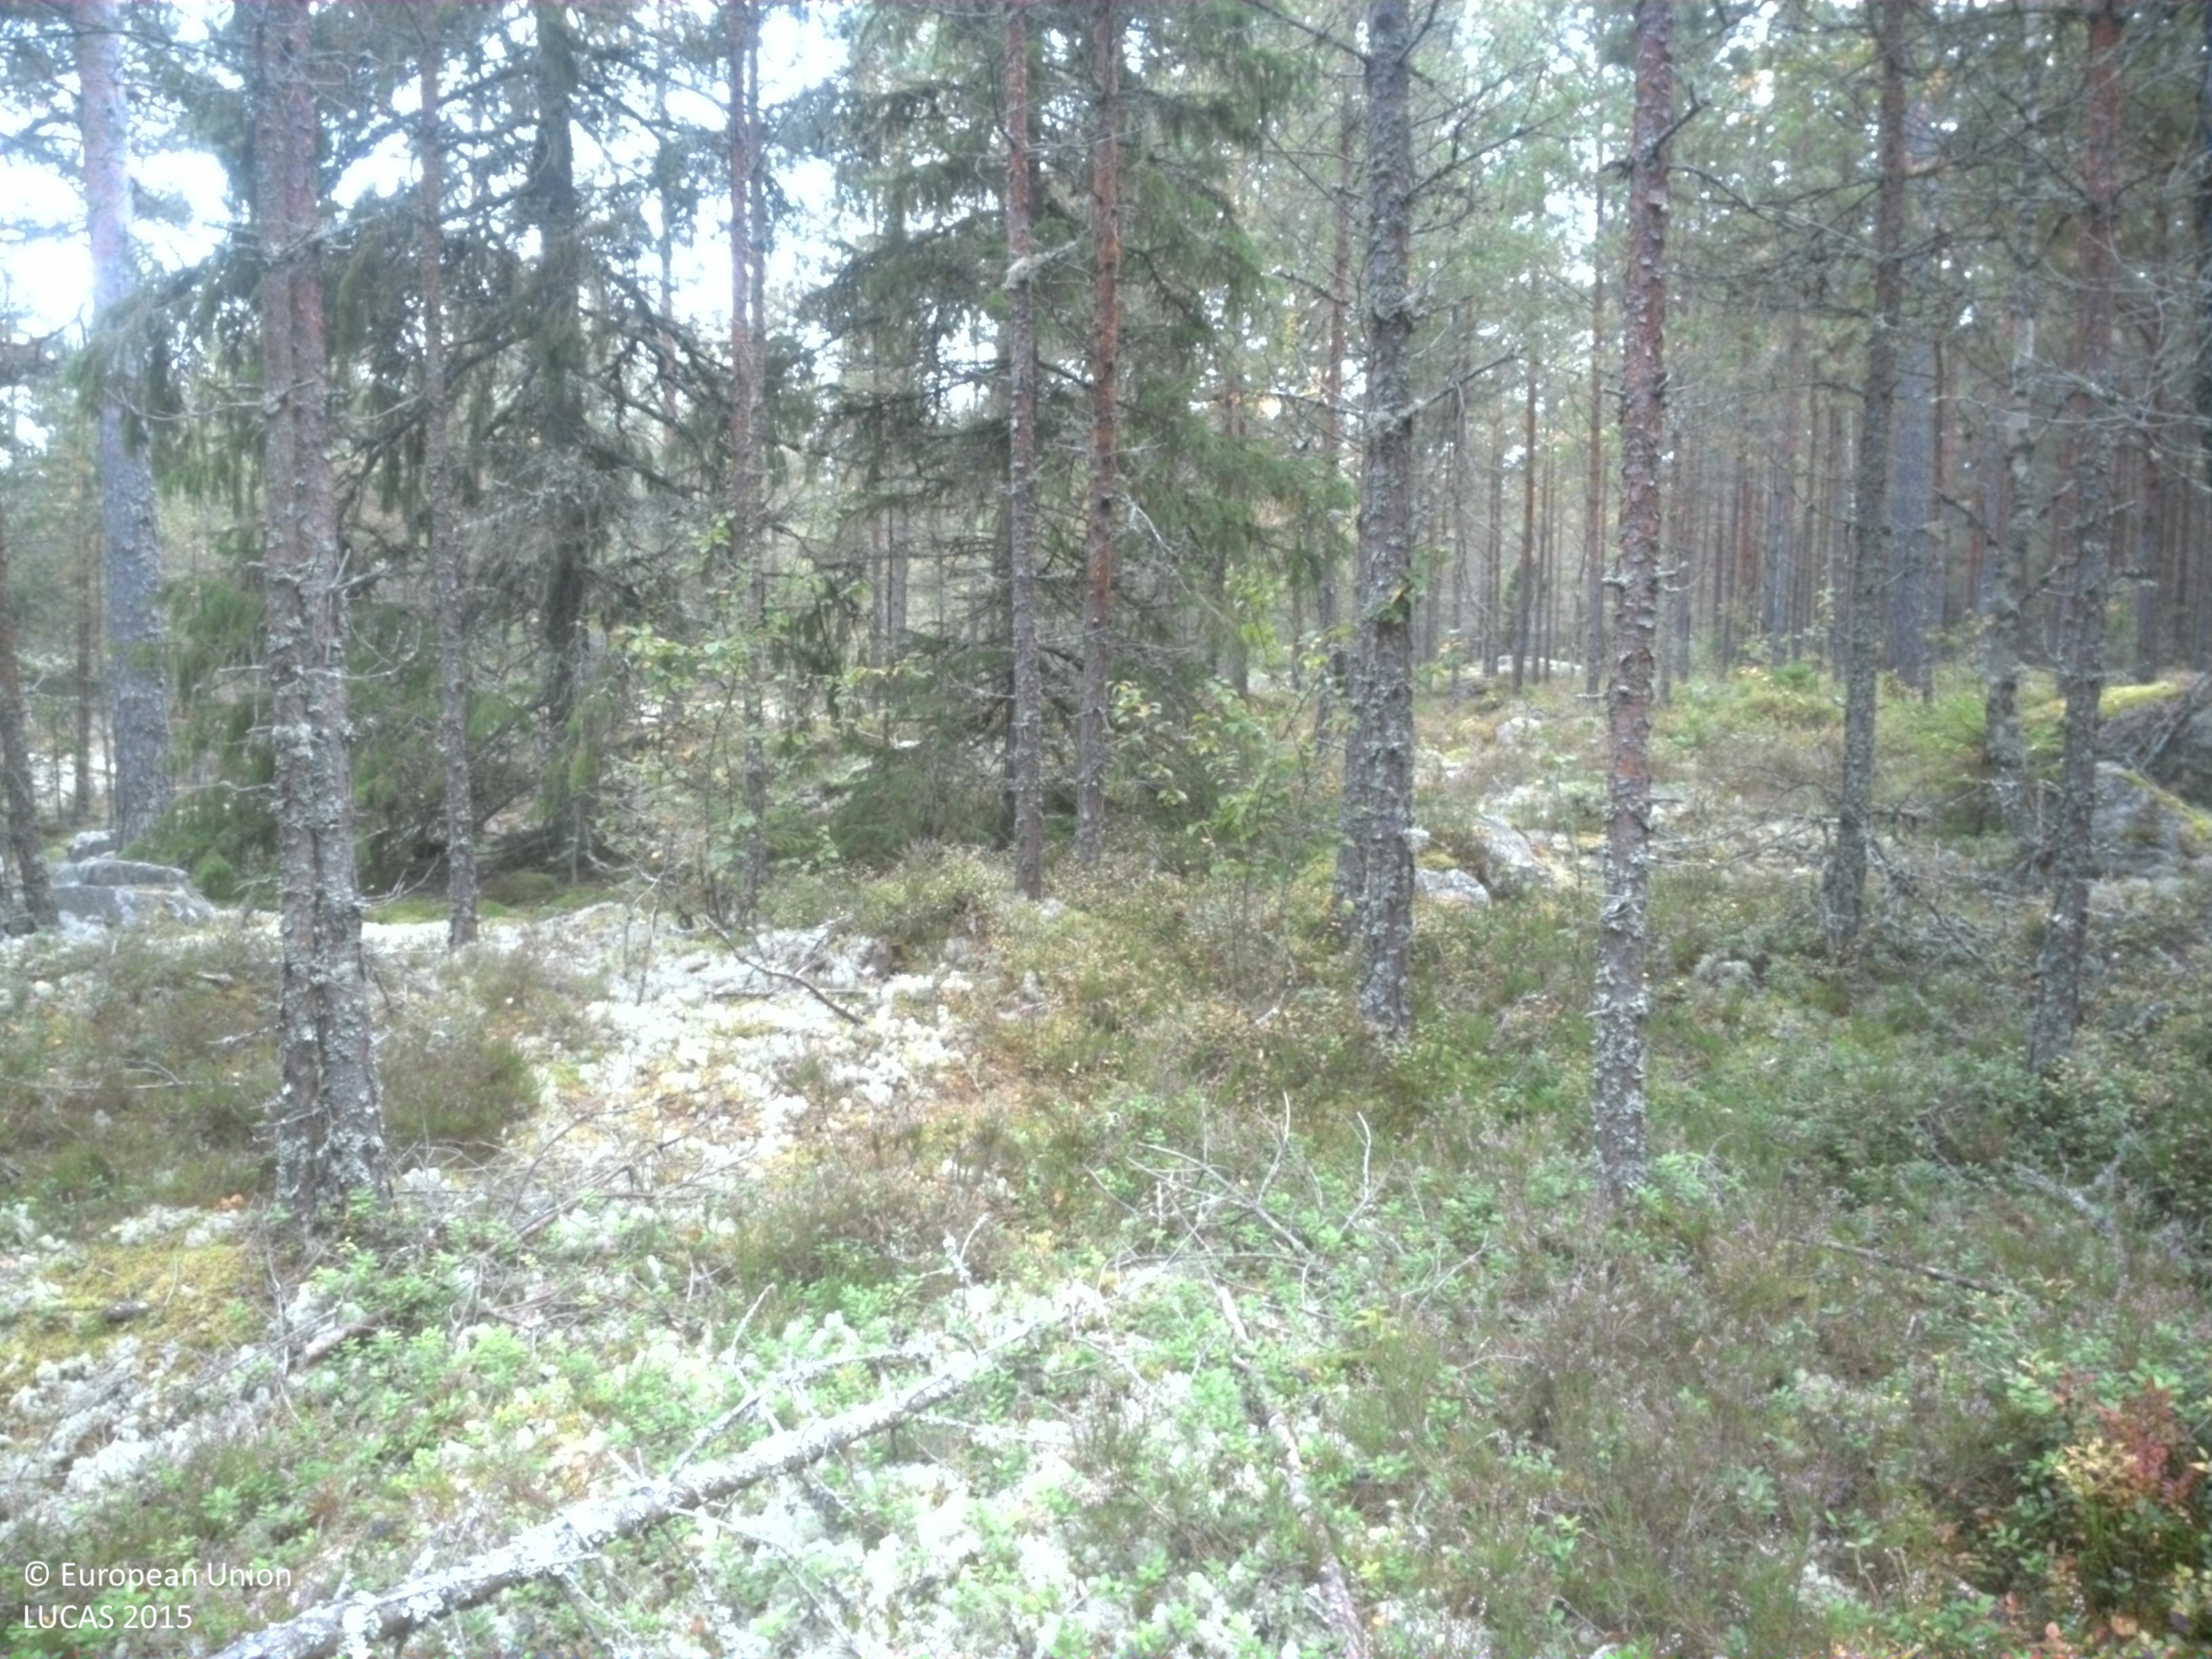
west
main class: Woodland
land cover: Pine dominated mixed woodland
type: boreal forest
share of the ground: > 75 %
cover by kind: coniferous forest trees 55 %, broadleaved forest trees 20 %, shrubs 15 %, lichens and mosses 5 %, consolidated bare surface 5 %
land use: Forestry
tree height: > 5 m
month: September
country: SE
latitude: 59.4042
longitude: 15.5400
